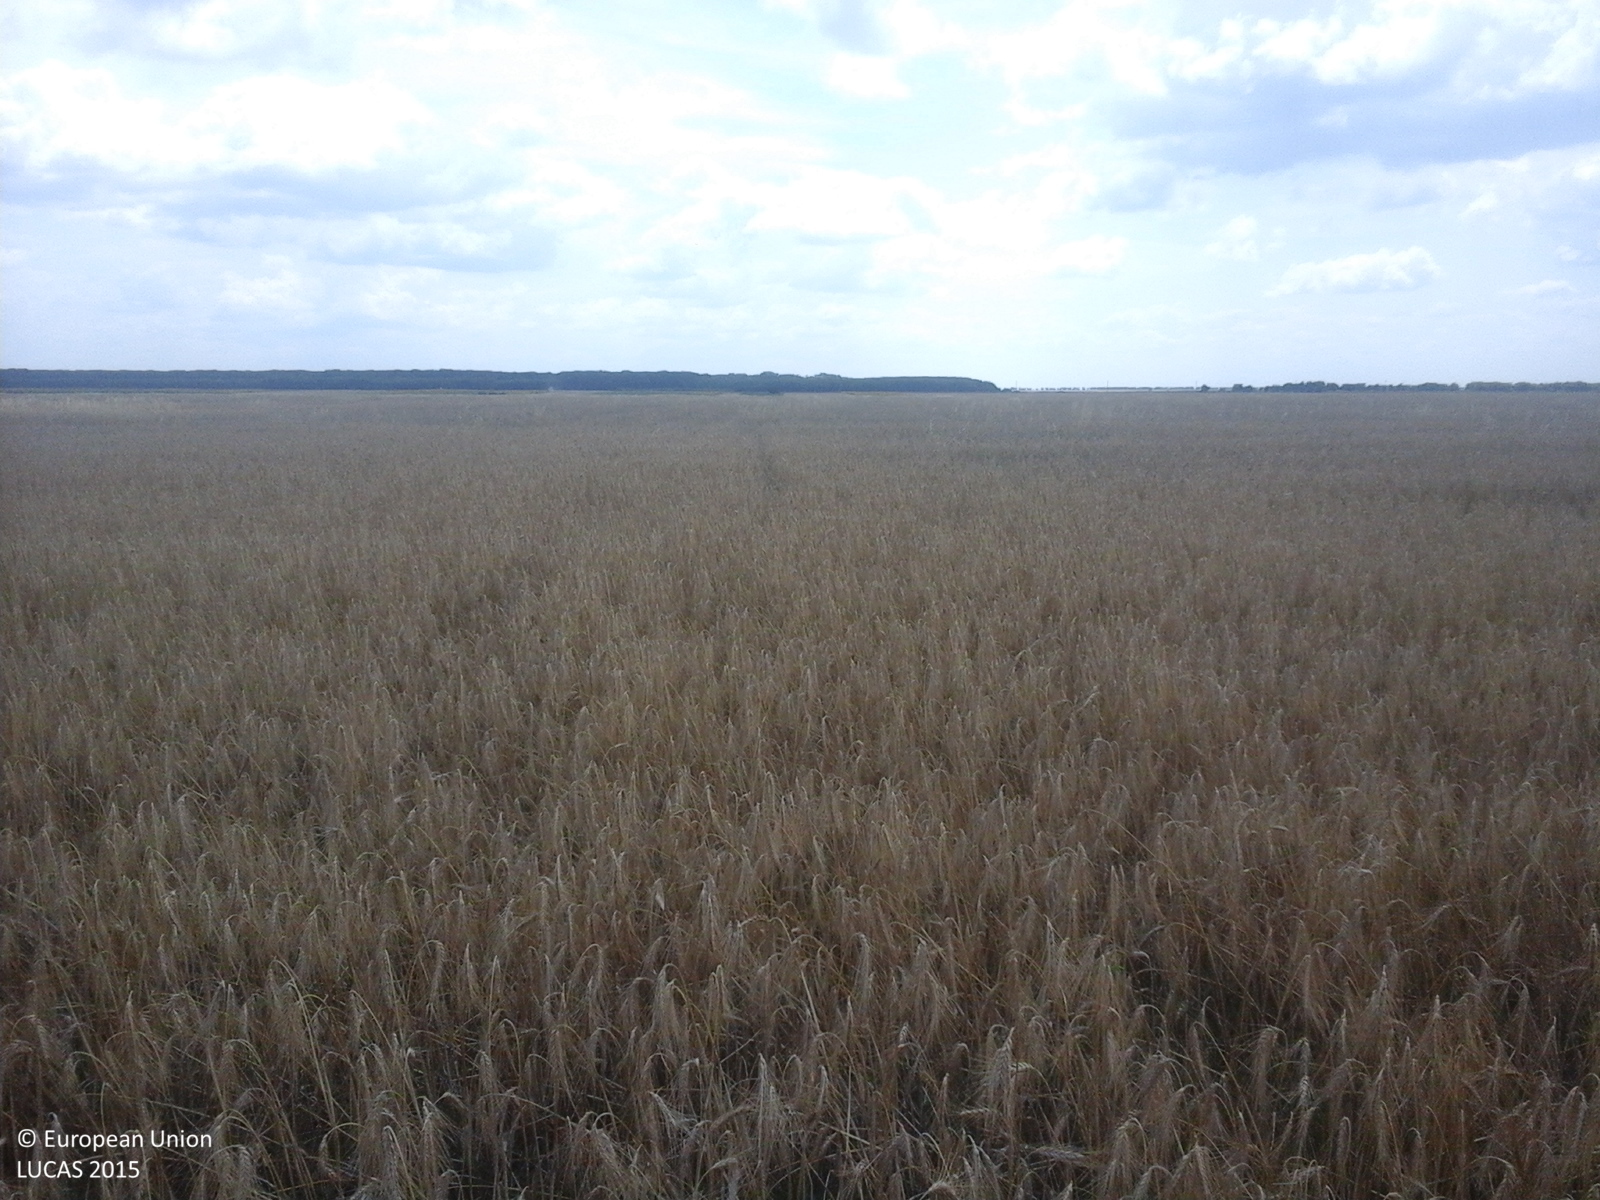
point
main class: Cropland
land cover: Common wheat
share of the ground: > 75 %
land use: Agriculture (excluding fallow land and kitchen gardens)
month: July
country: RO
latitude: 43.9109
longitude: 24.2440
